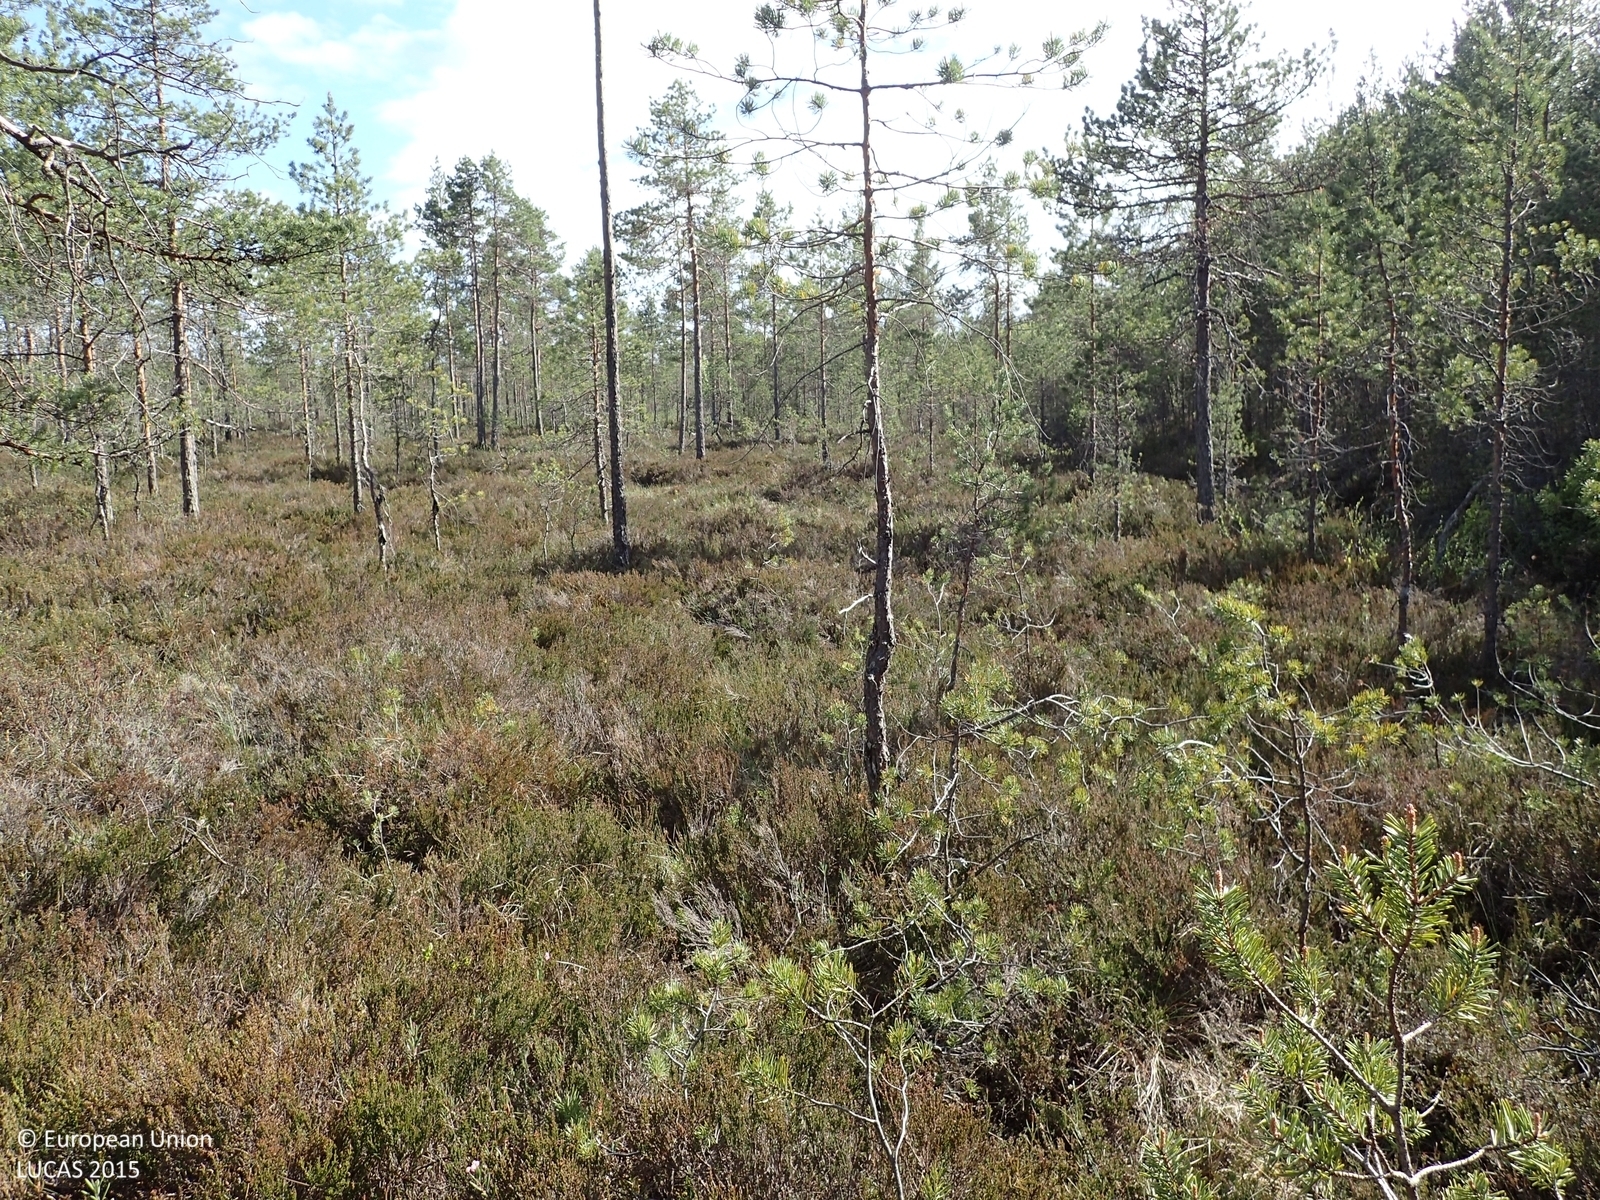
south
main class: Woodland
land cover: Pine dominated coniferous woodland
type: mire and swamp forests
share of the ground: 50 - 75 %
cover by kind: coniferous forest trees 50 %, shrubs 50 %
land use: Semi-natural and natural areas not in use
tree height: > 5 m
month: June
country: FI
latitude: 62.2729
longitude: 21.8204
